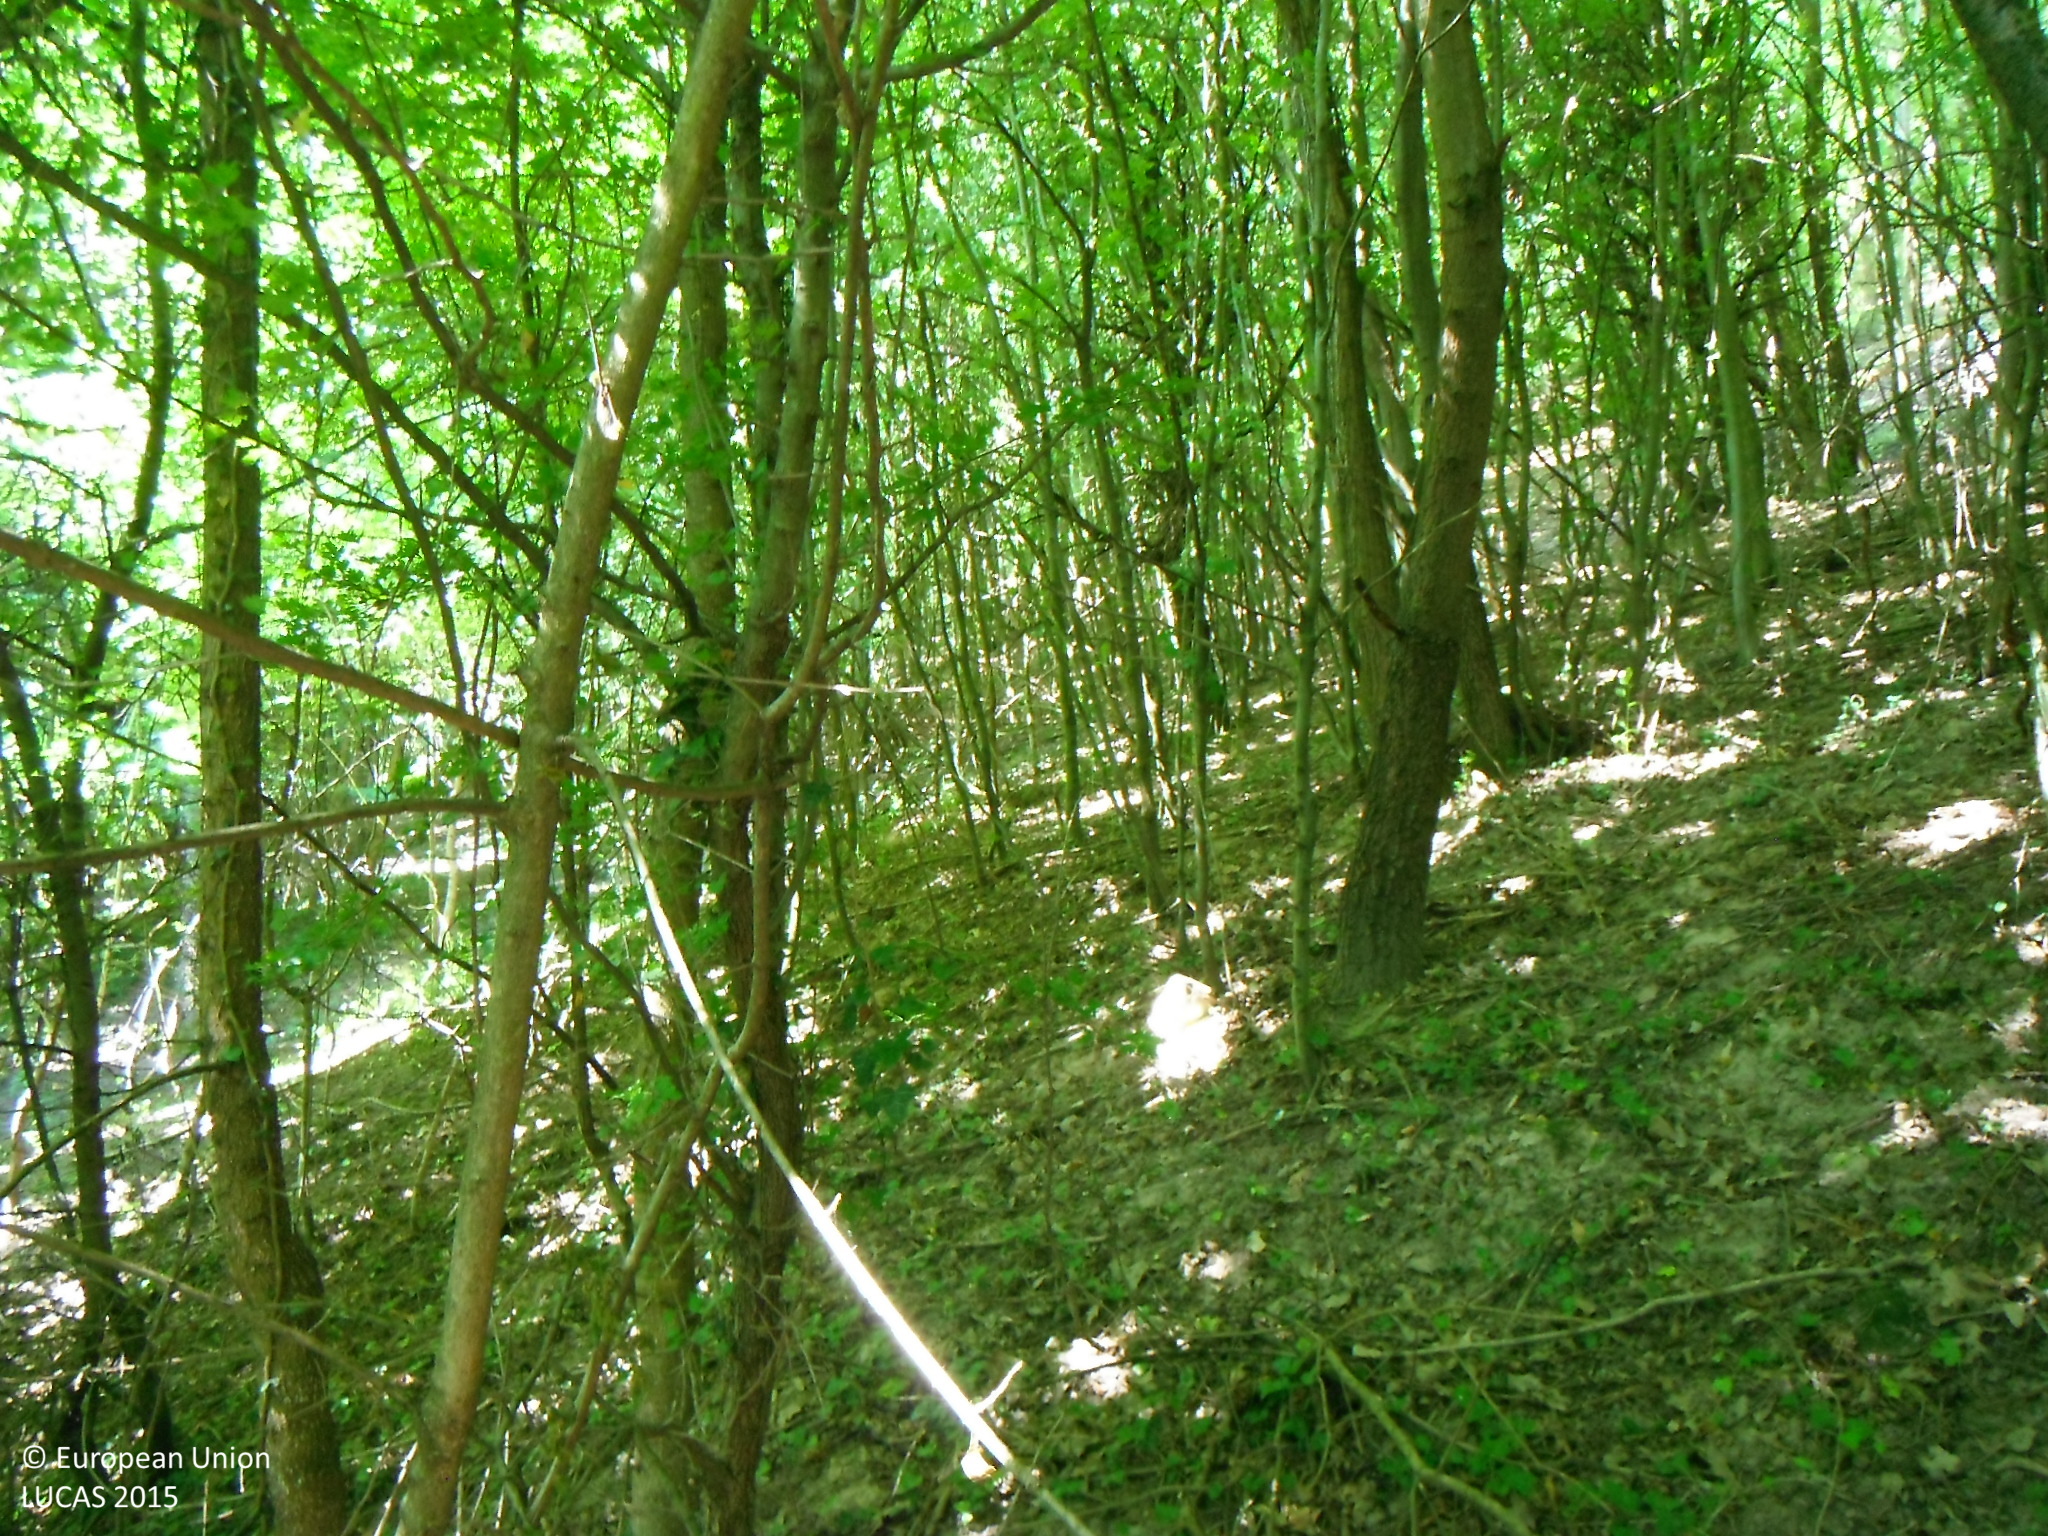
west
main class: Woodland
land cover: Broadleaved woodland
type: mesophytic deciduous forest
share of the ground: > 75 %
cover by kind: broadleaved forest trees 95 %, herbaceous plants 5 %
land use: Forestry
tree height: > 5 m
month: June
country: SK
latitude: 48.5107
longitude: 18.7225
